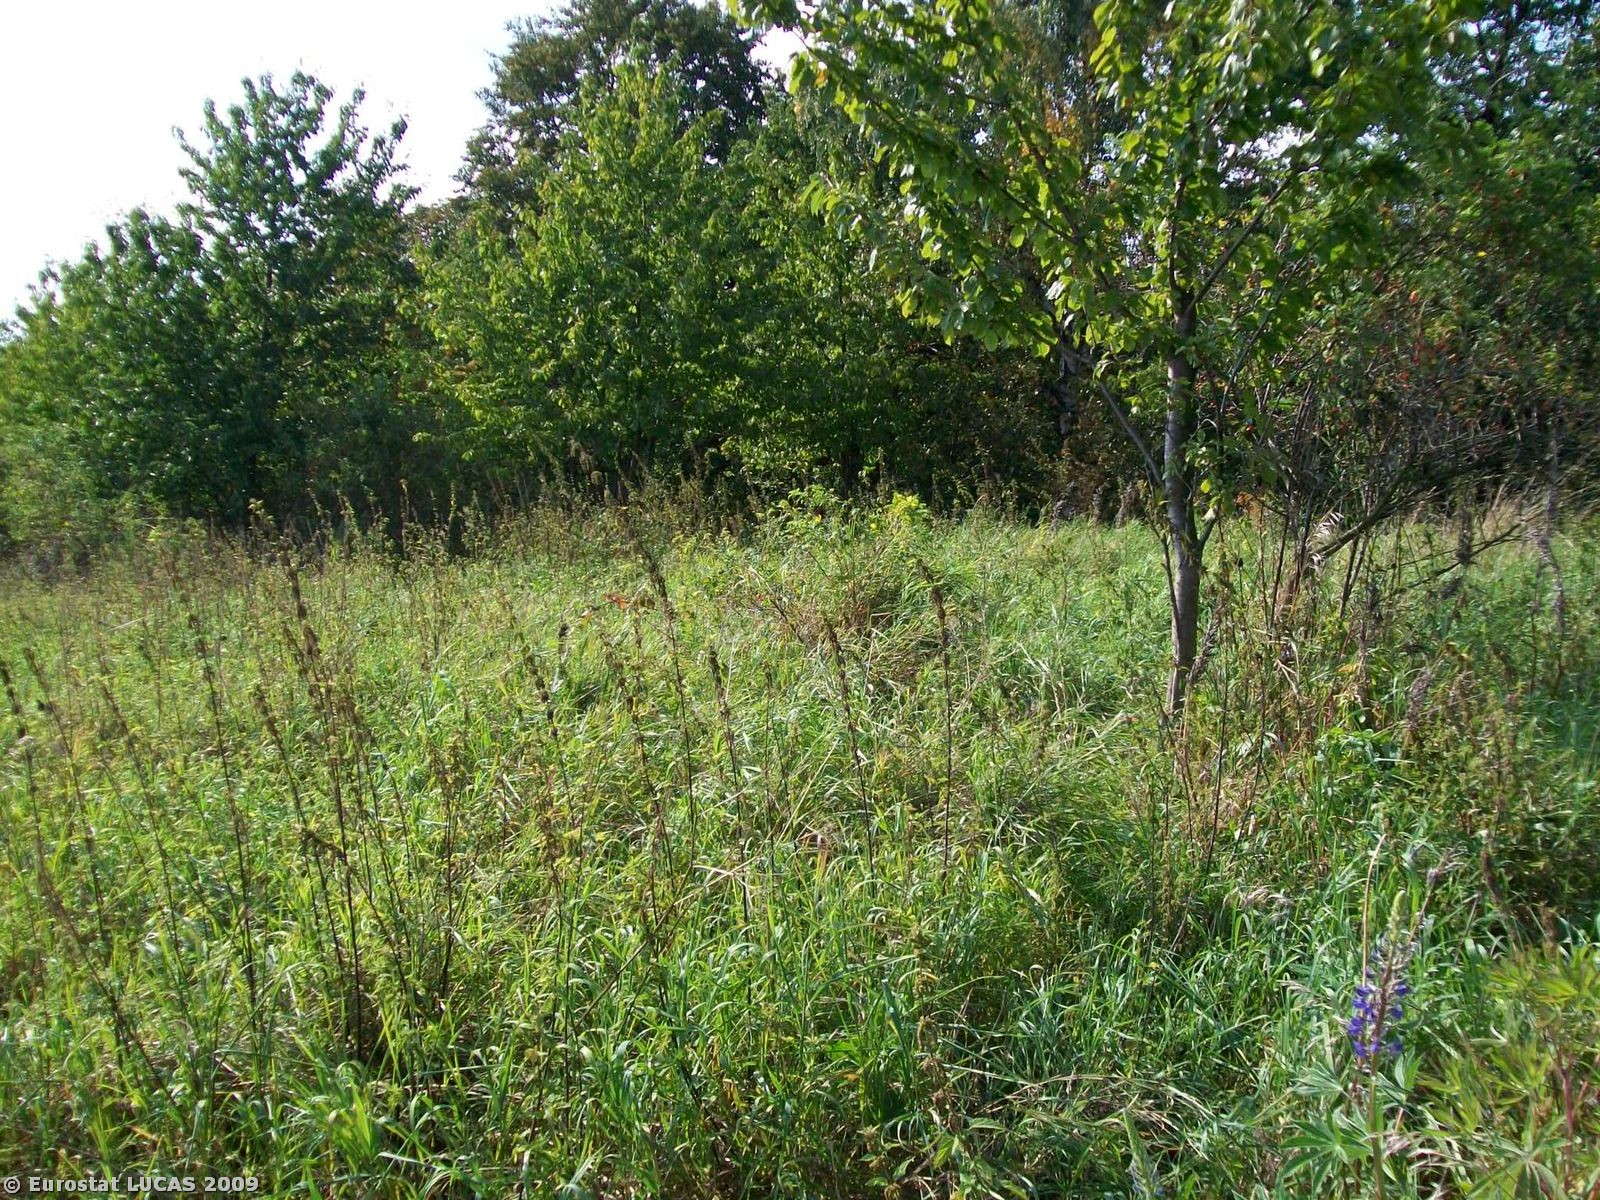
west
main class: Grassland
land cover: Grassland without tree/shrub cover
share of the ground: > 75 %
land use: Unused
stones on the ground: < 10 %
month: September
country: PL
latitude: 50.6336
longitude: 16.7529
